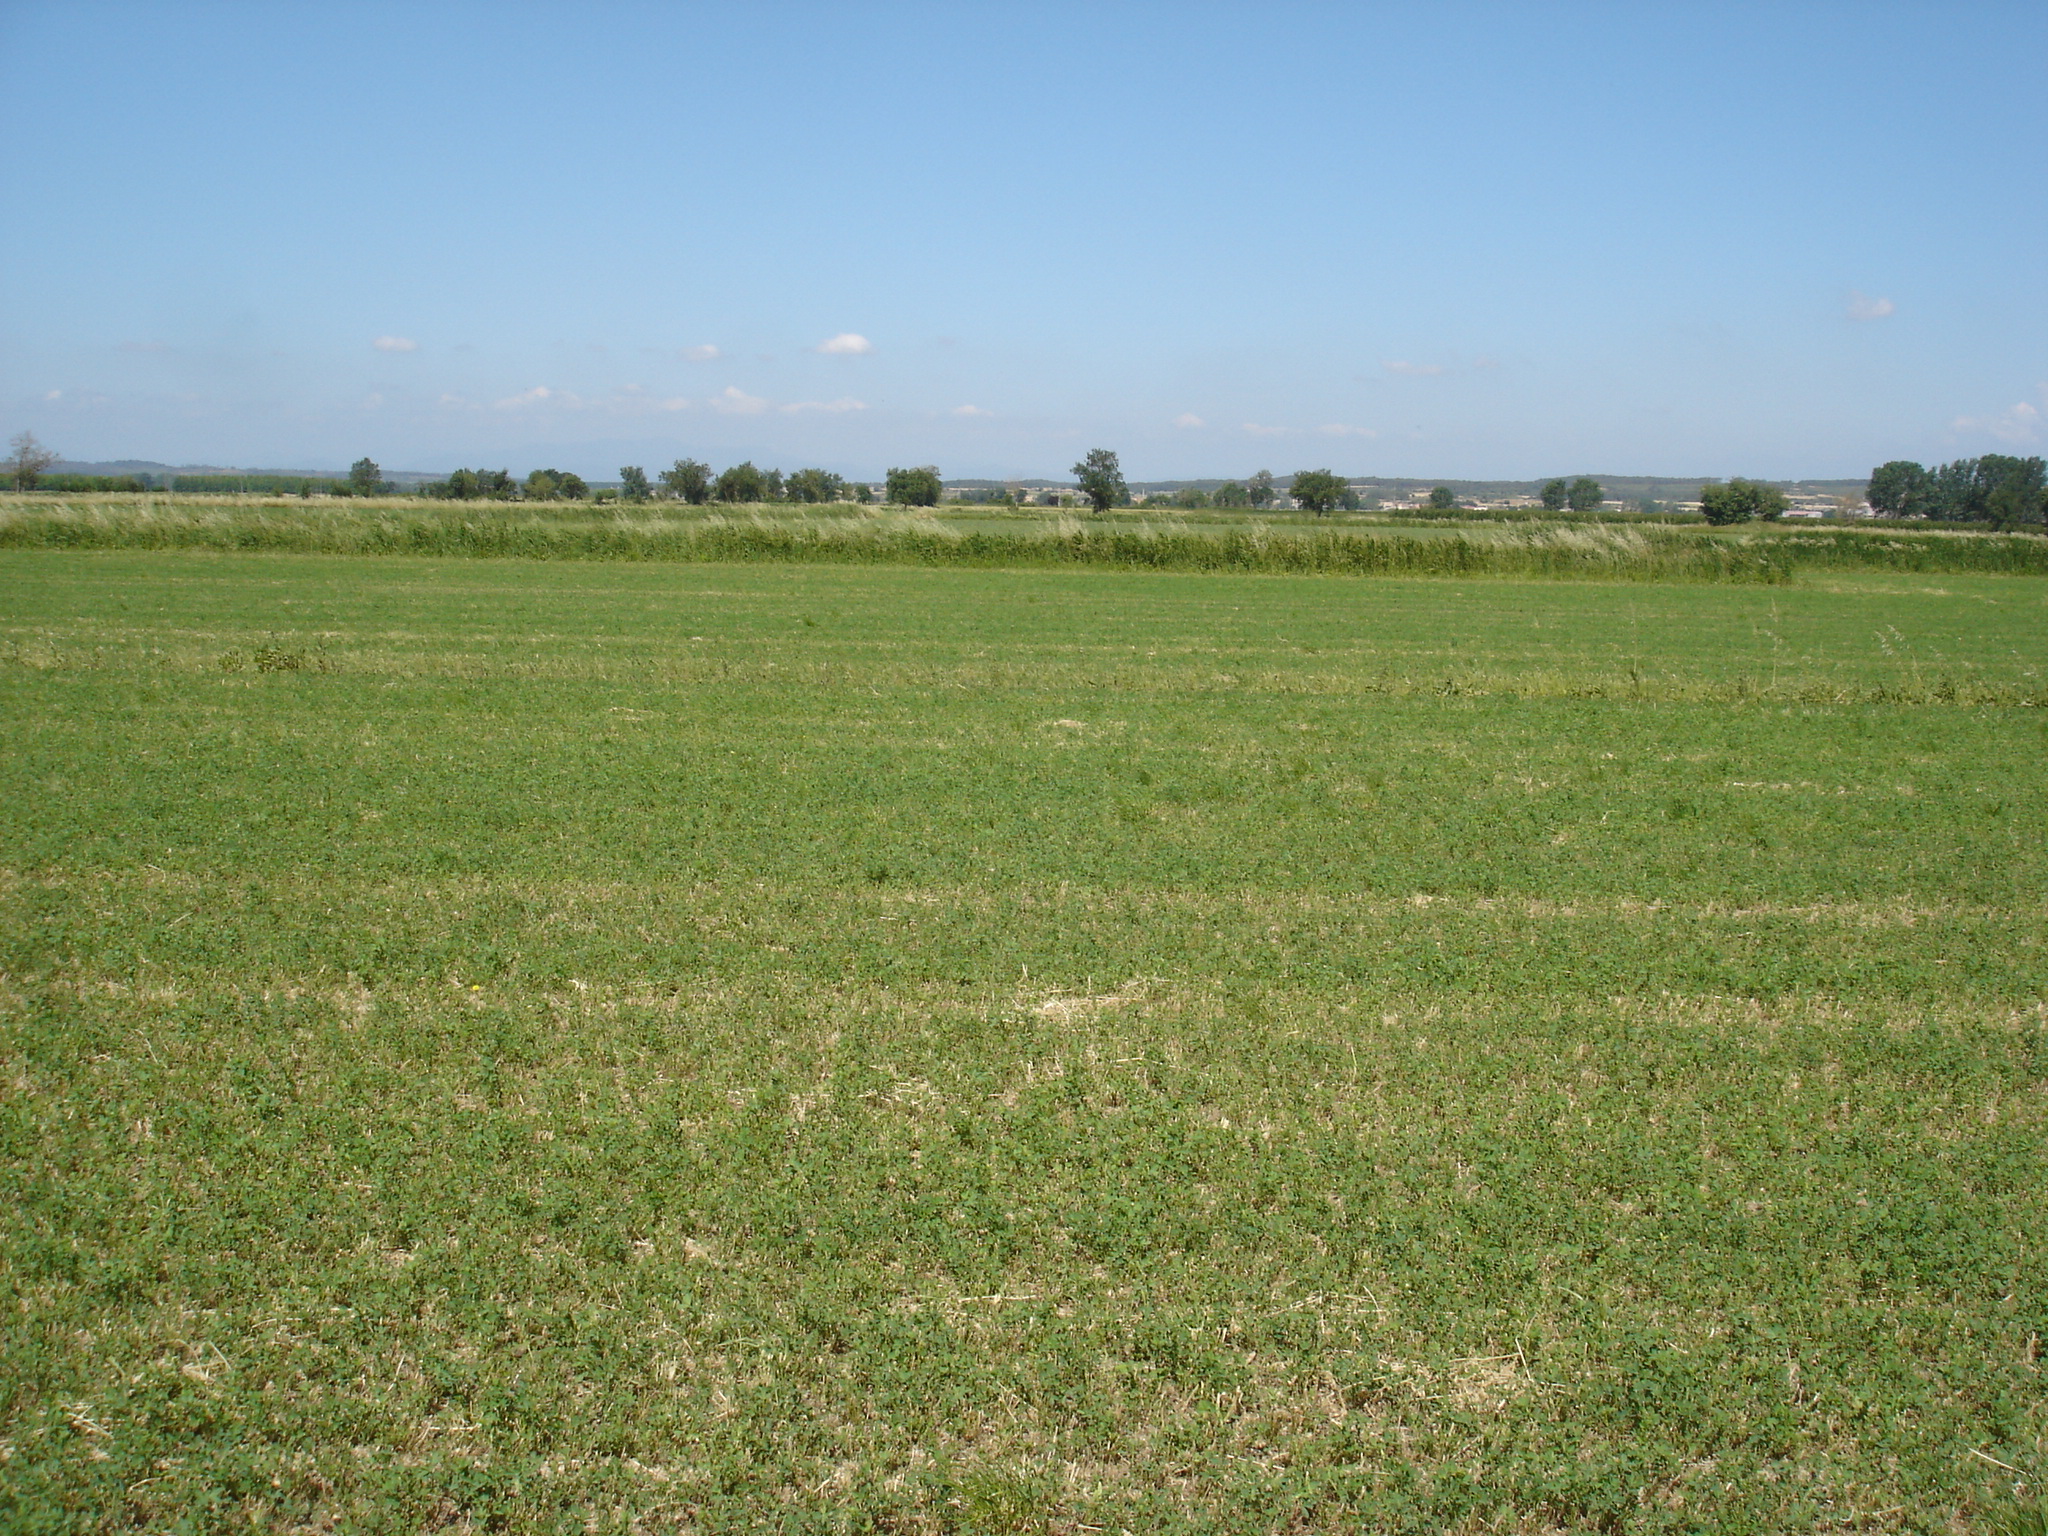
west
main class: Cropland
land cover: Lucerne
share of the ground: > 75 %
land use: Agriculture (excluding fallow land and kitchen gardens)
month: May
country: ES
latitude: 42.0735
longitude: 3.0897
